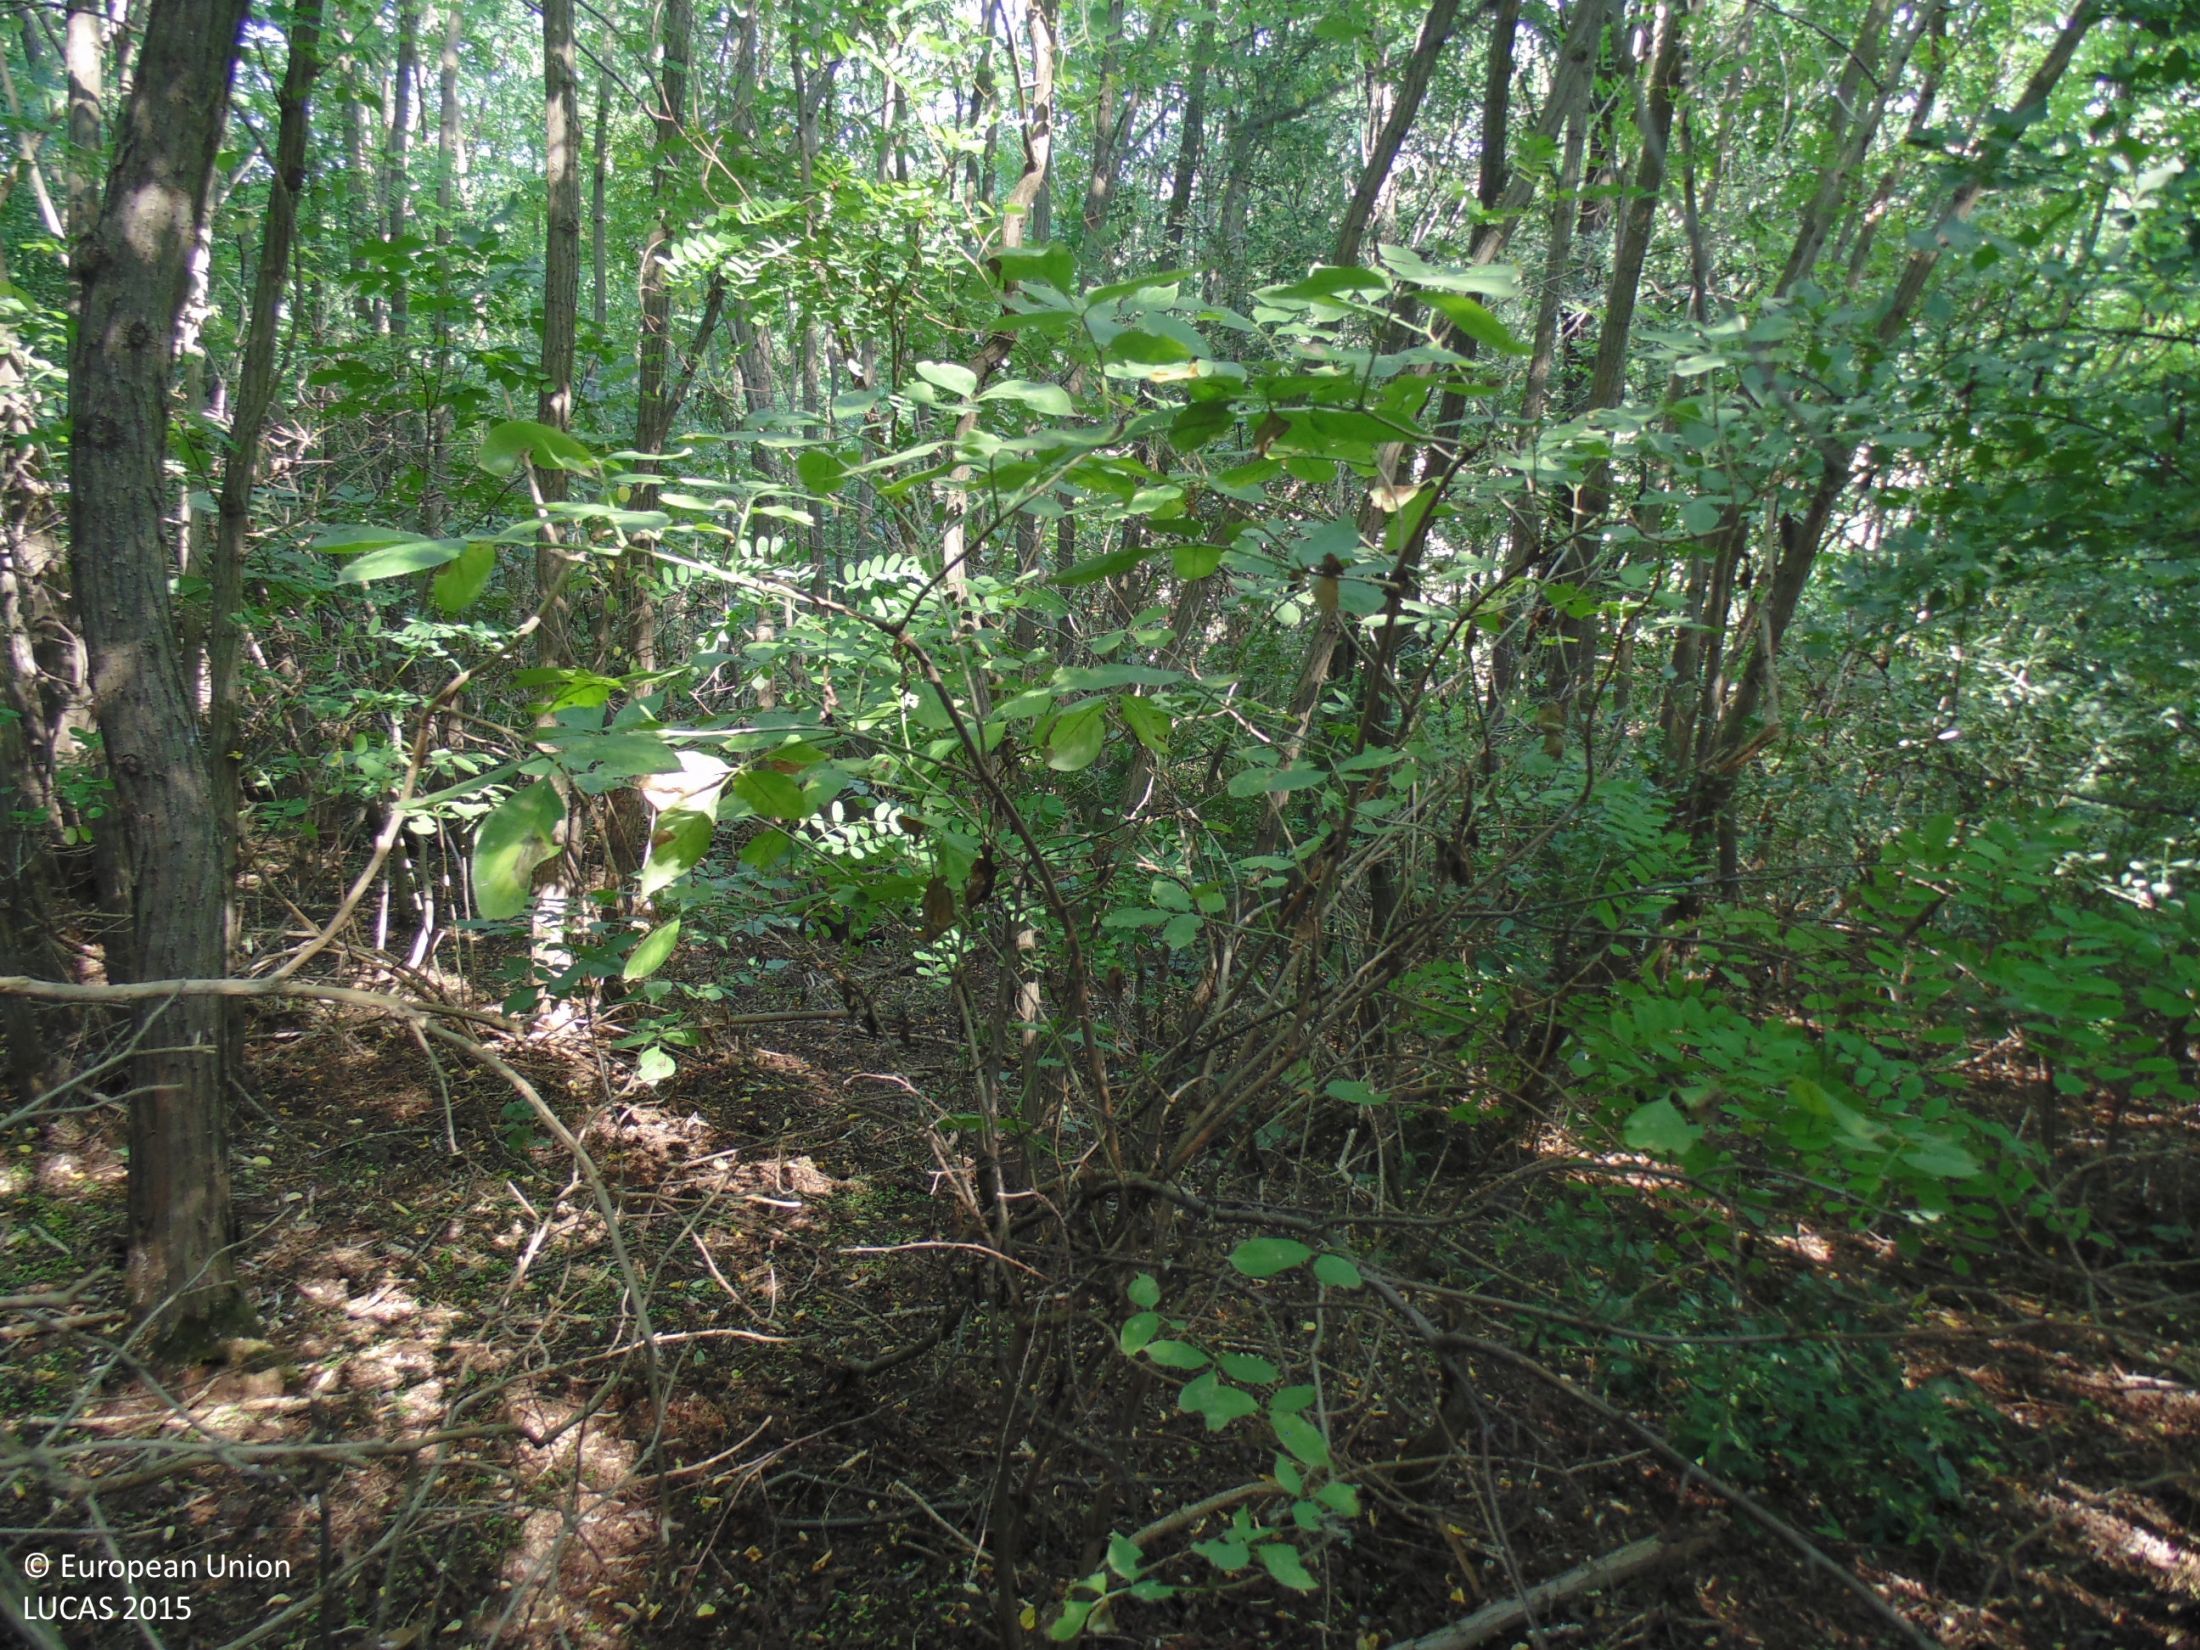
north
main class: Woodland
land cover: Broadleaved woodland
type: mesophytic deciduous forest
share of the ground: > 75 %
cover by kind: broadleaved forest trees 95 %, herbaceous plants 5 %
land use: Forestry
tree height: > 5 m
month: August
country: BG
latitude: 44.0545
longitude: 27.3465
